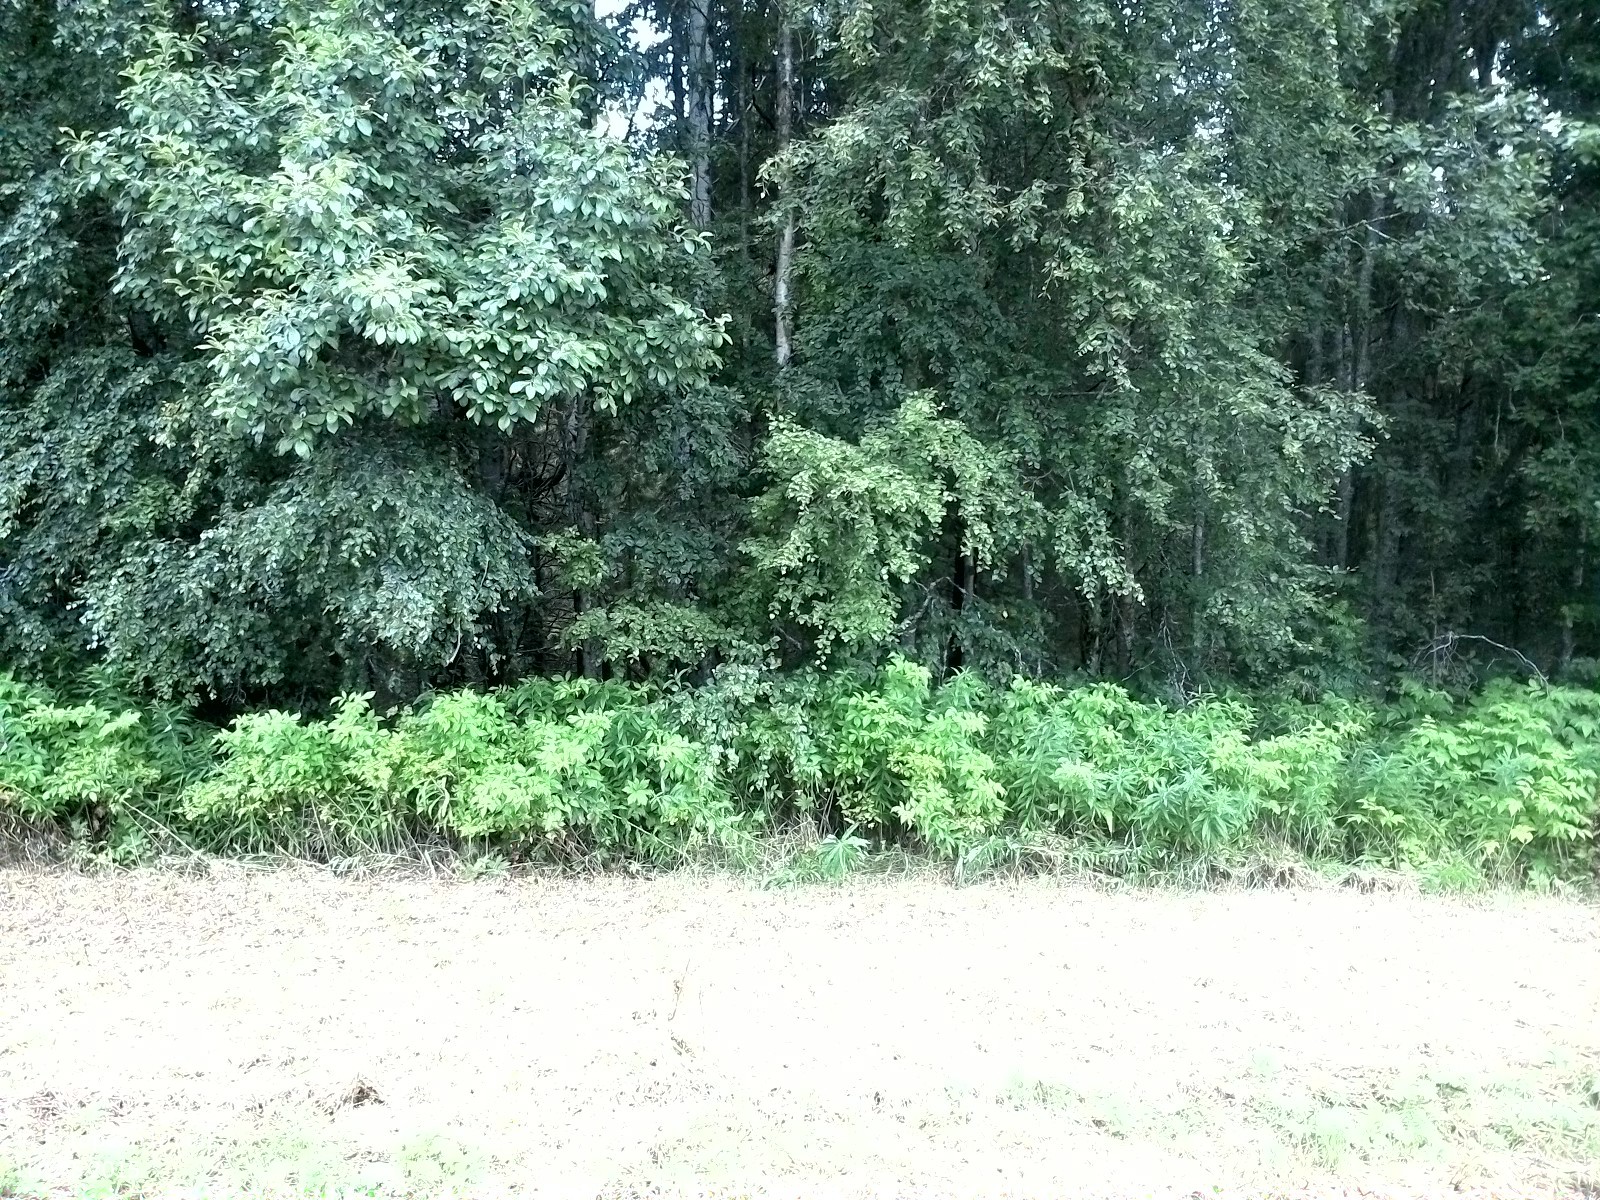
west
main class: Grassland
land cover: Spontaneously vegetated surfaces
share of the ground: < 10 %
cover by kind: herbaceous plants 10 %, unconsolidated bare surface 10 %
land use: Agriculture (excluding fallow land and kitchen gardens)
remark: Harvested field
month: August
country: SE
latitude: 62.5527
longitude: 17.1163
